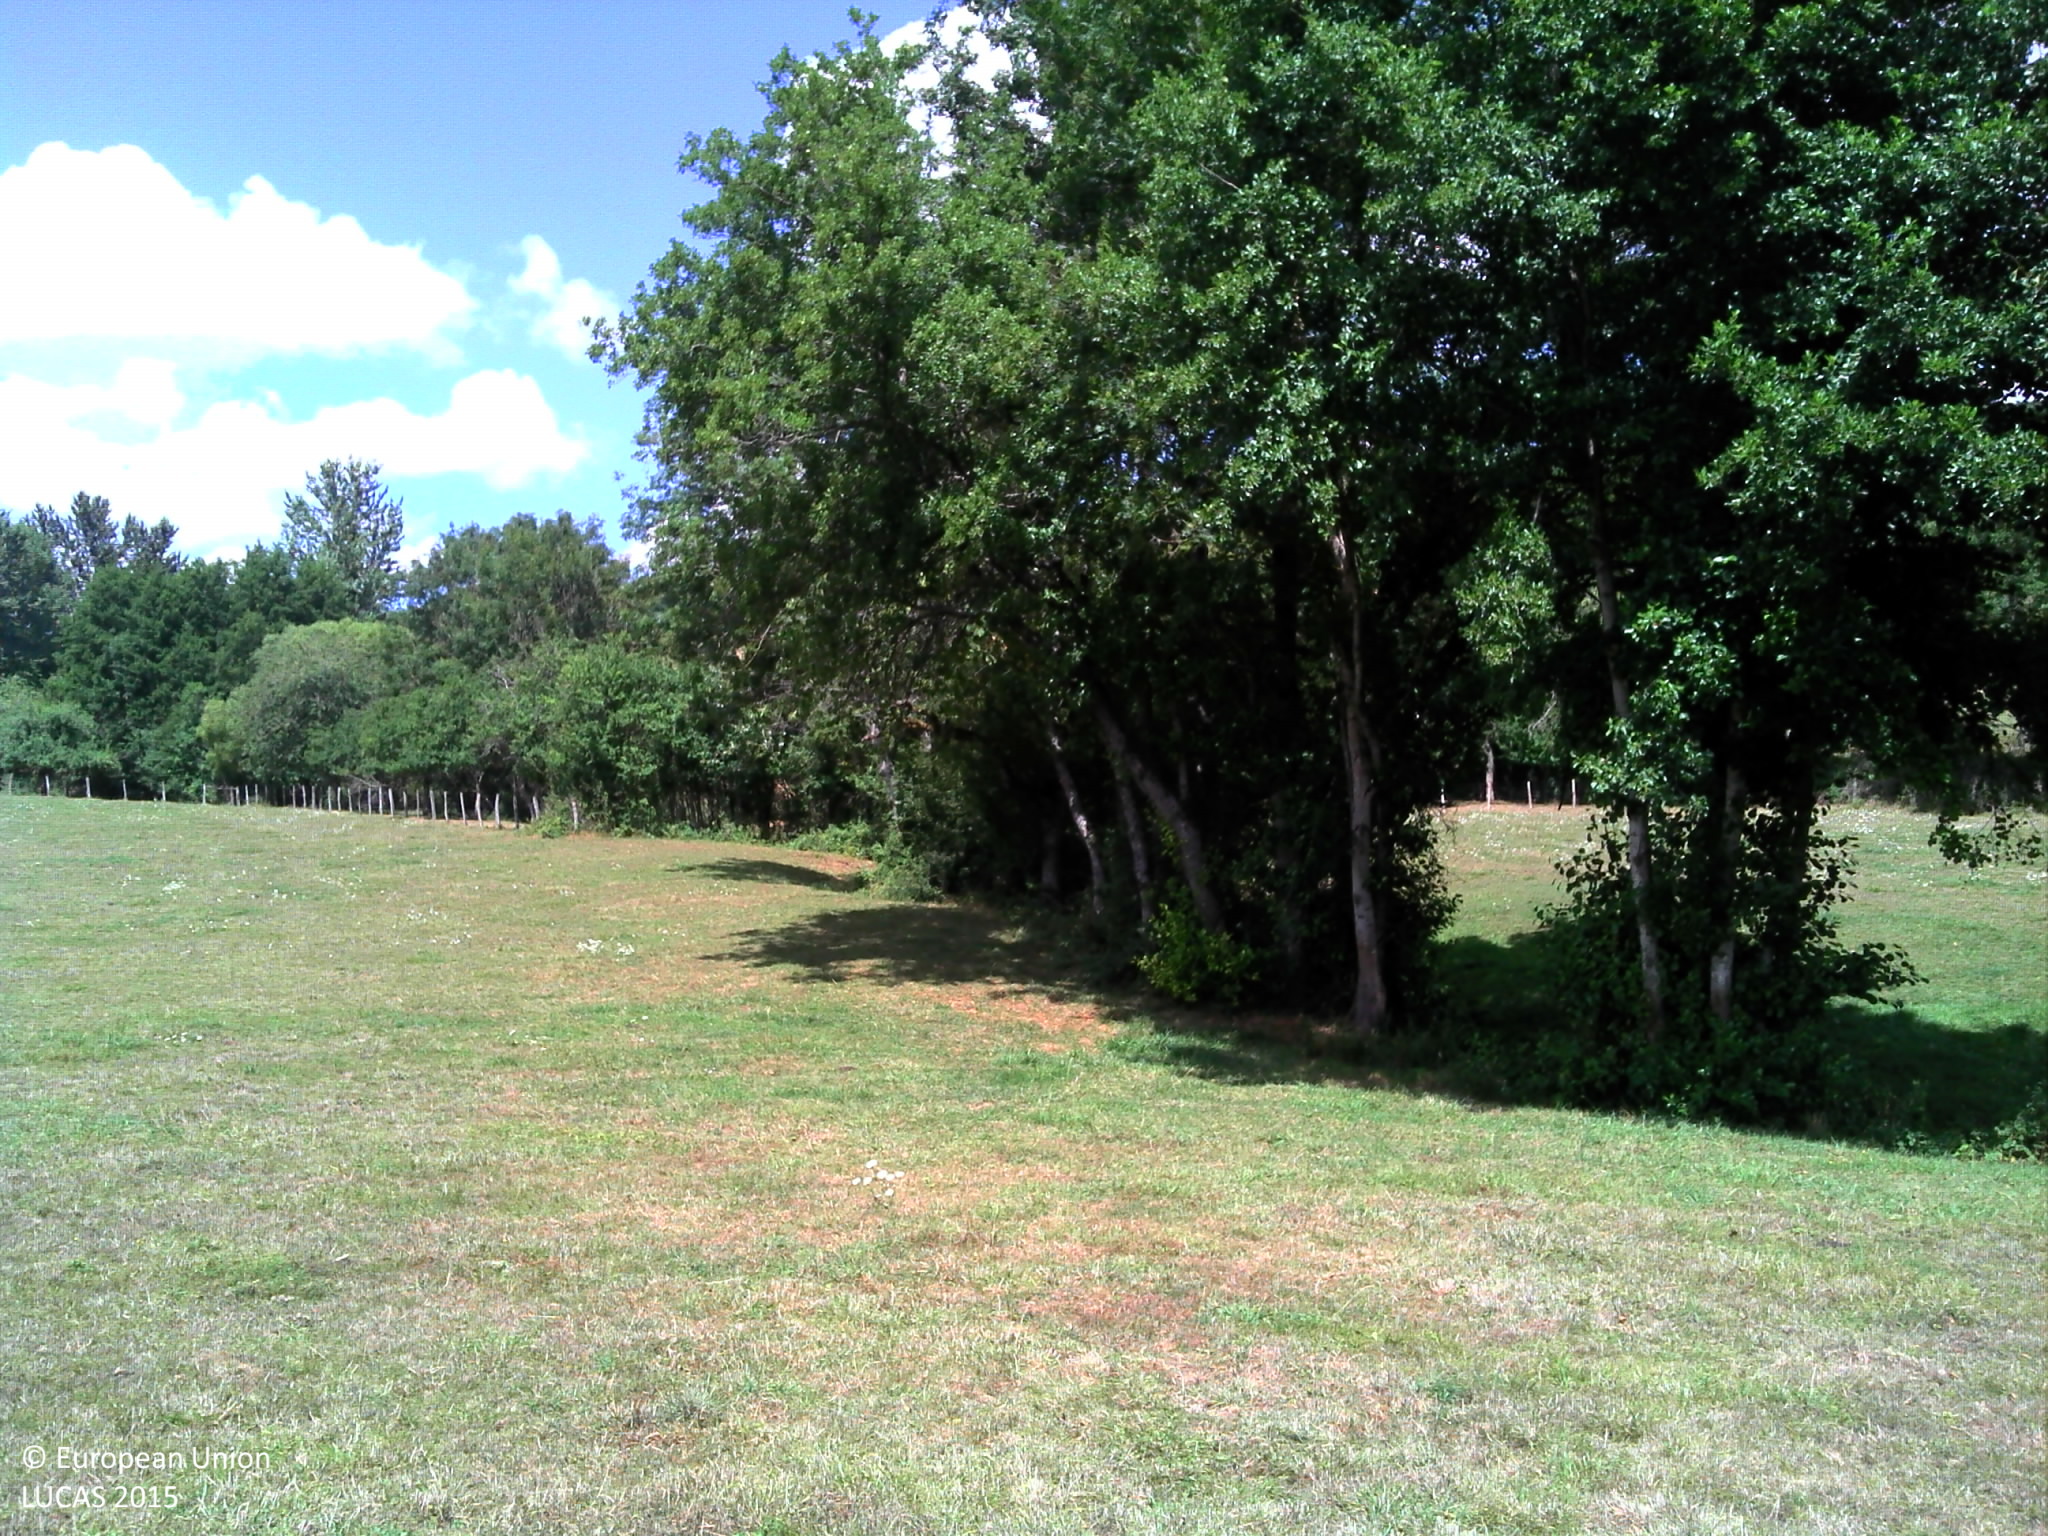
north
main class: Grassland
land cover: Grassland without tree/shrub cover
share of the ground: > 75 %
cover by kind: herbaceous plants 100 %
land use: Agriculture (excluding fallow land and kitchen gardens)
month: July
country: FR
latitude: 47.7792
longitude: 5.2622
